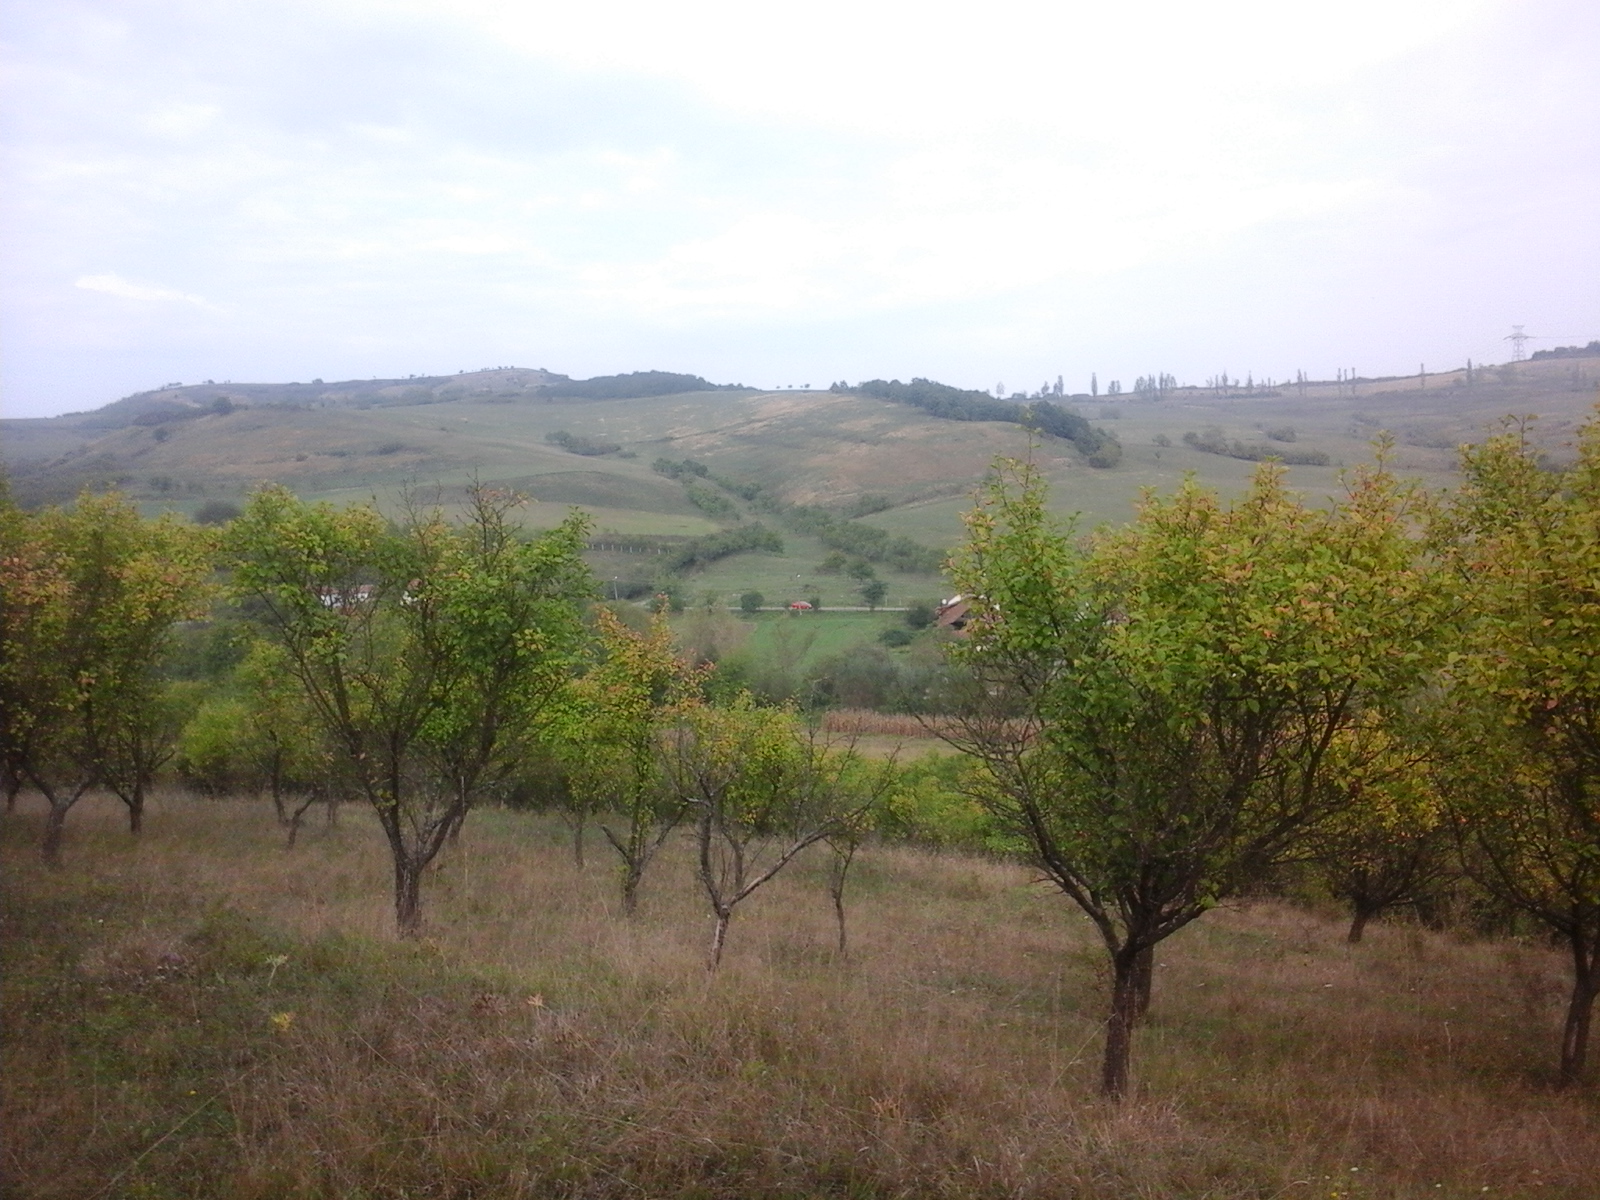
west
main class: Cropland
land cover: Other fruit trees and berries
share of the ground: > 75 %
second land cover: Grassland without tree/shrub cover
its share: > 75 %
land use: Agriculture (excluding fallow land and kitchen gardens)
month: September
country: RO
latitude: 45.7222
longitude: 22.9663
